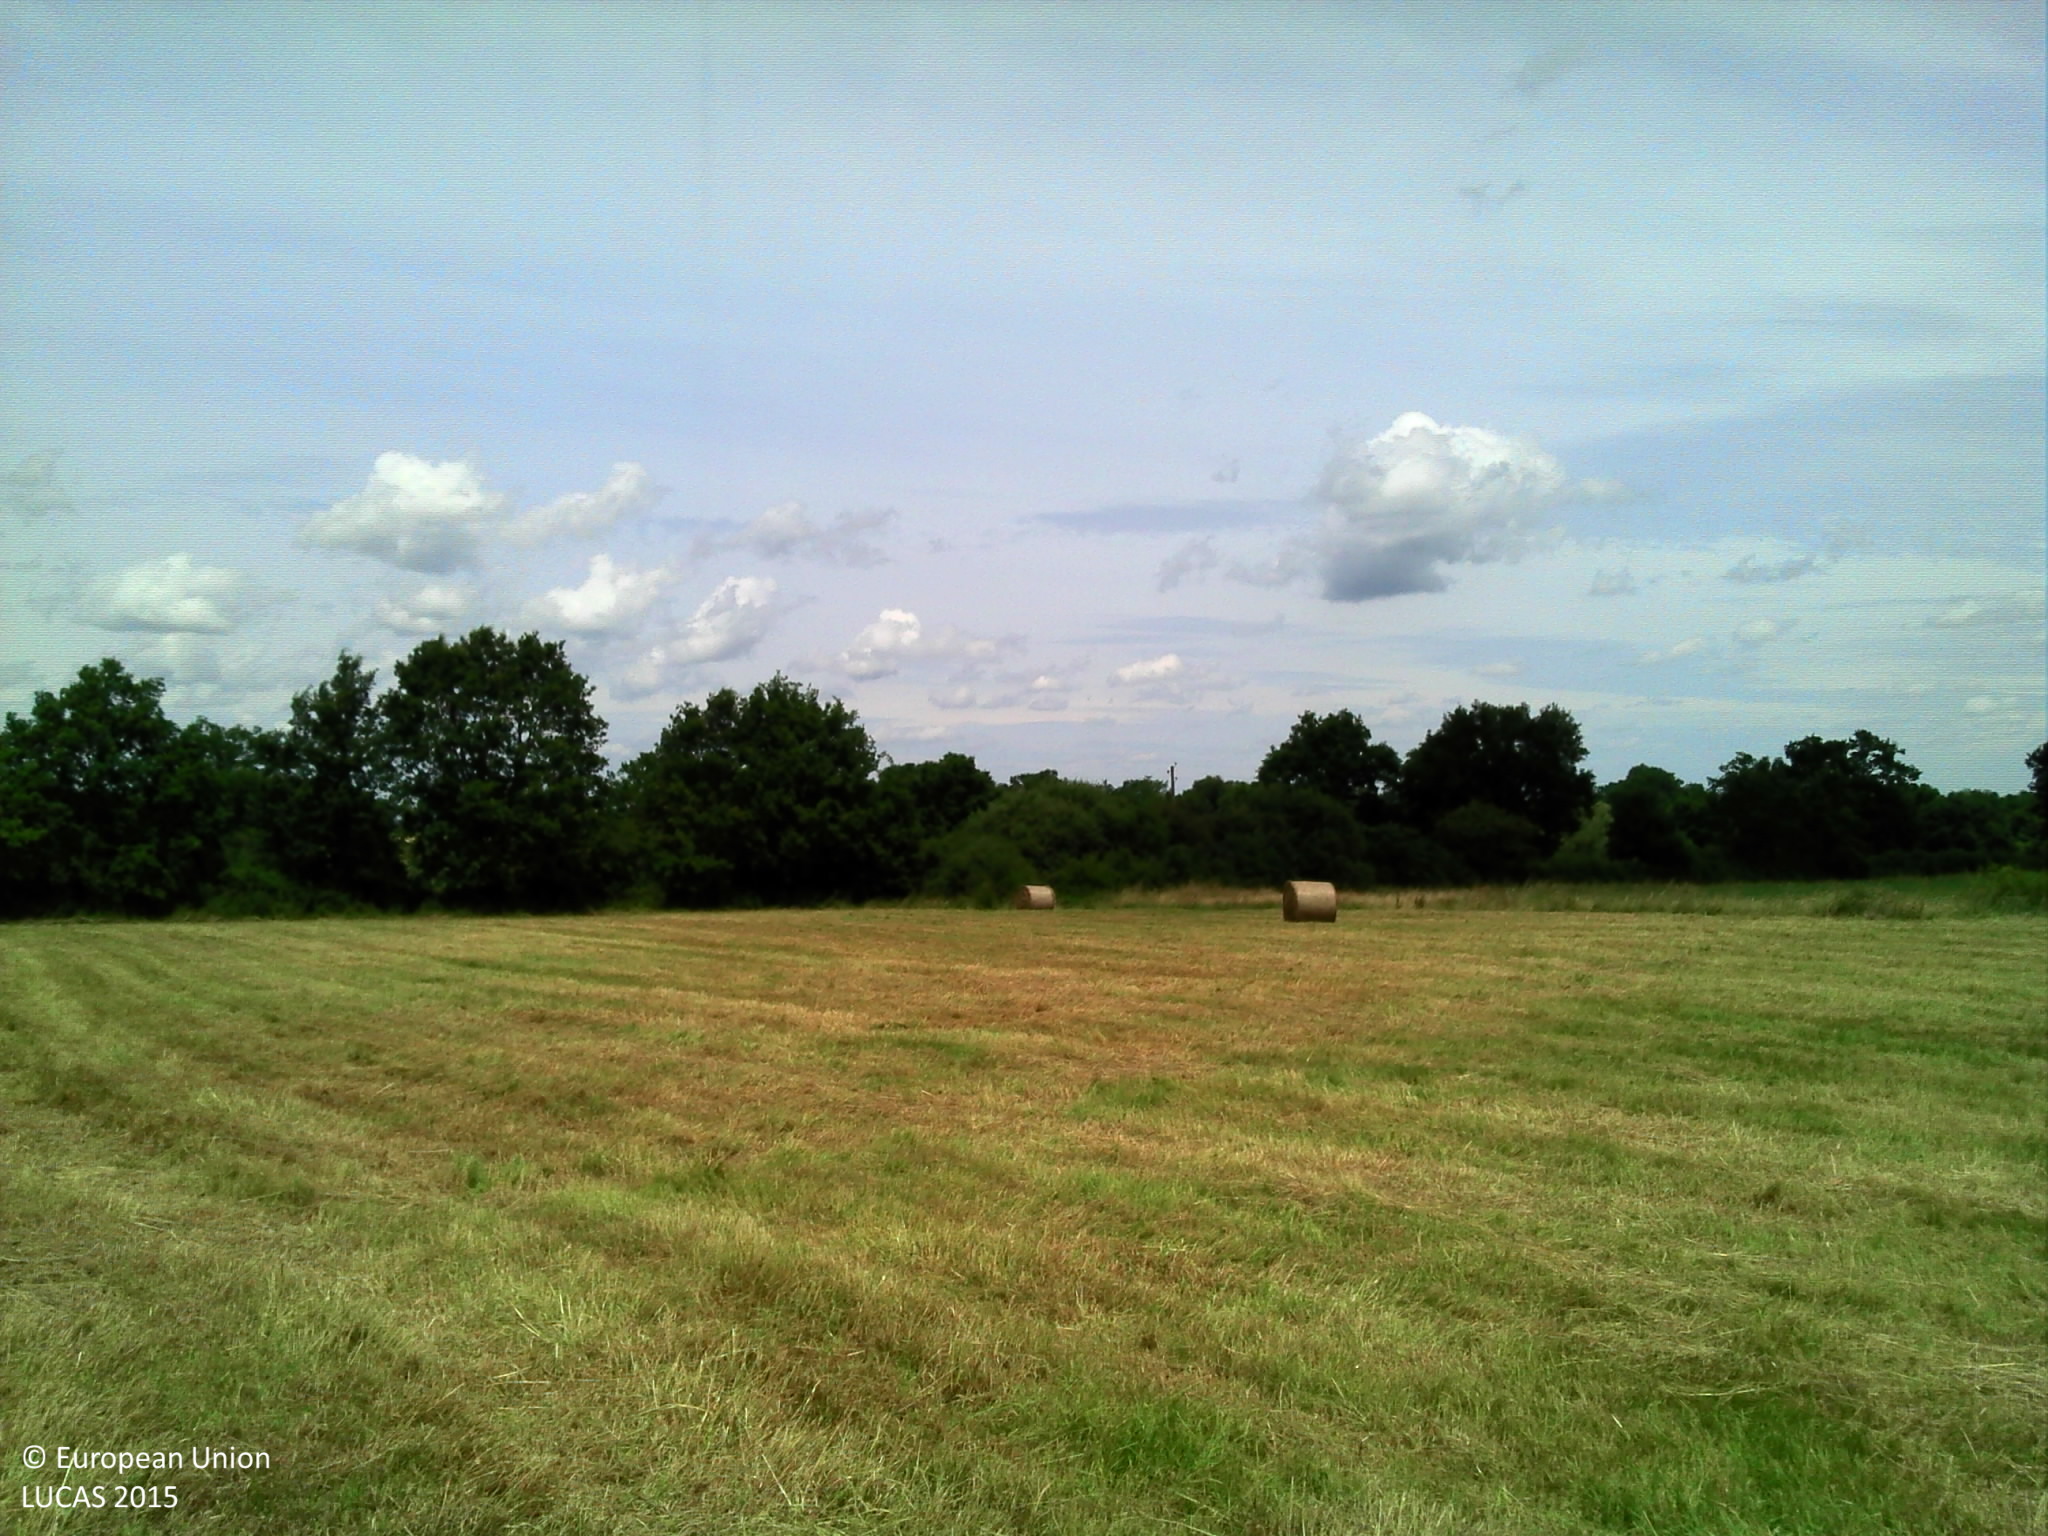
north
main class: Grassland
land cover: Grassland without tree/shrub cover
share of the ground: > 75 %
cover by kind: herbaceous plants 100 %
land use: Agriculture (excluding fallow land and kitchen gardens)
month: June
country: FR
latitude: 46.4267
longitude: 3.2446
